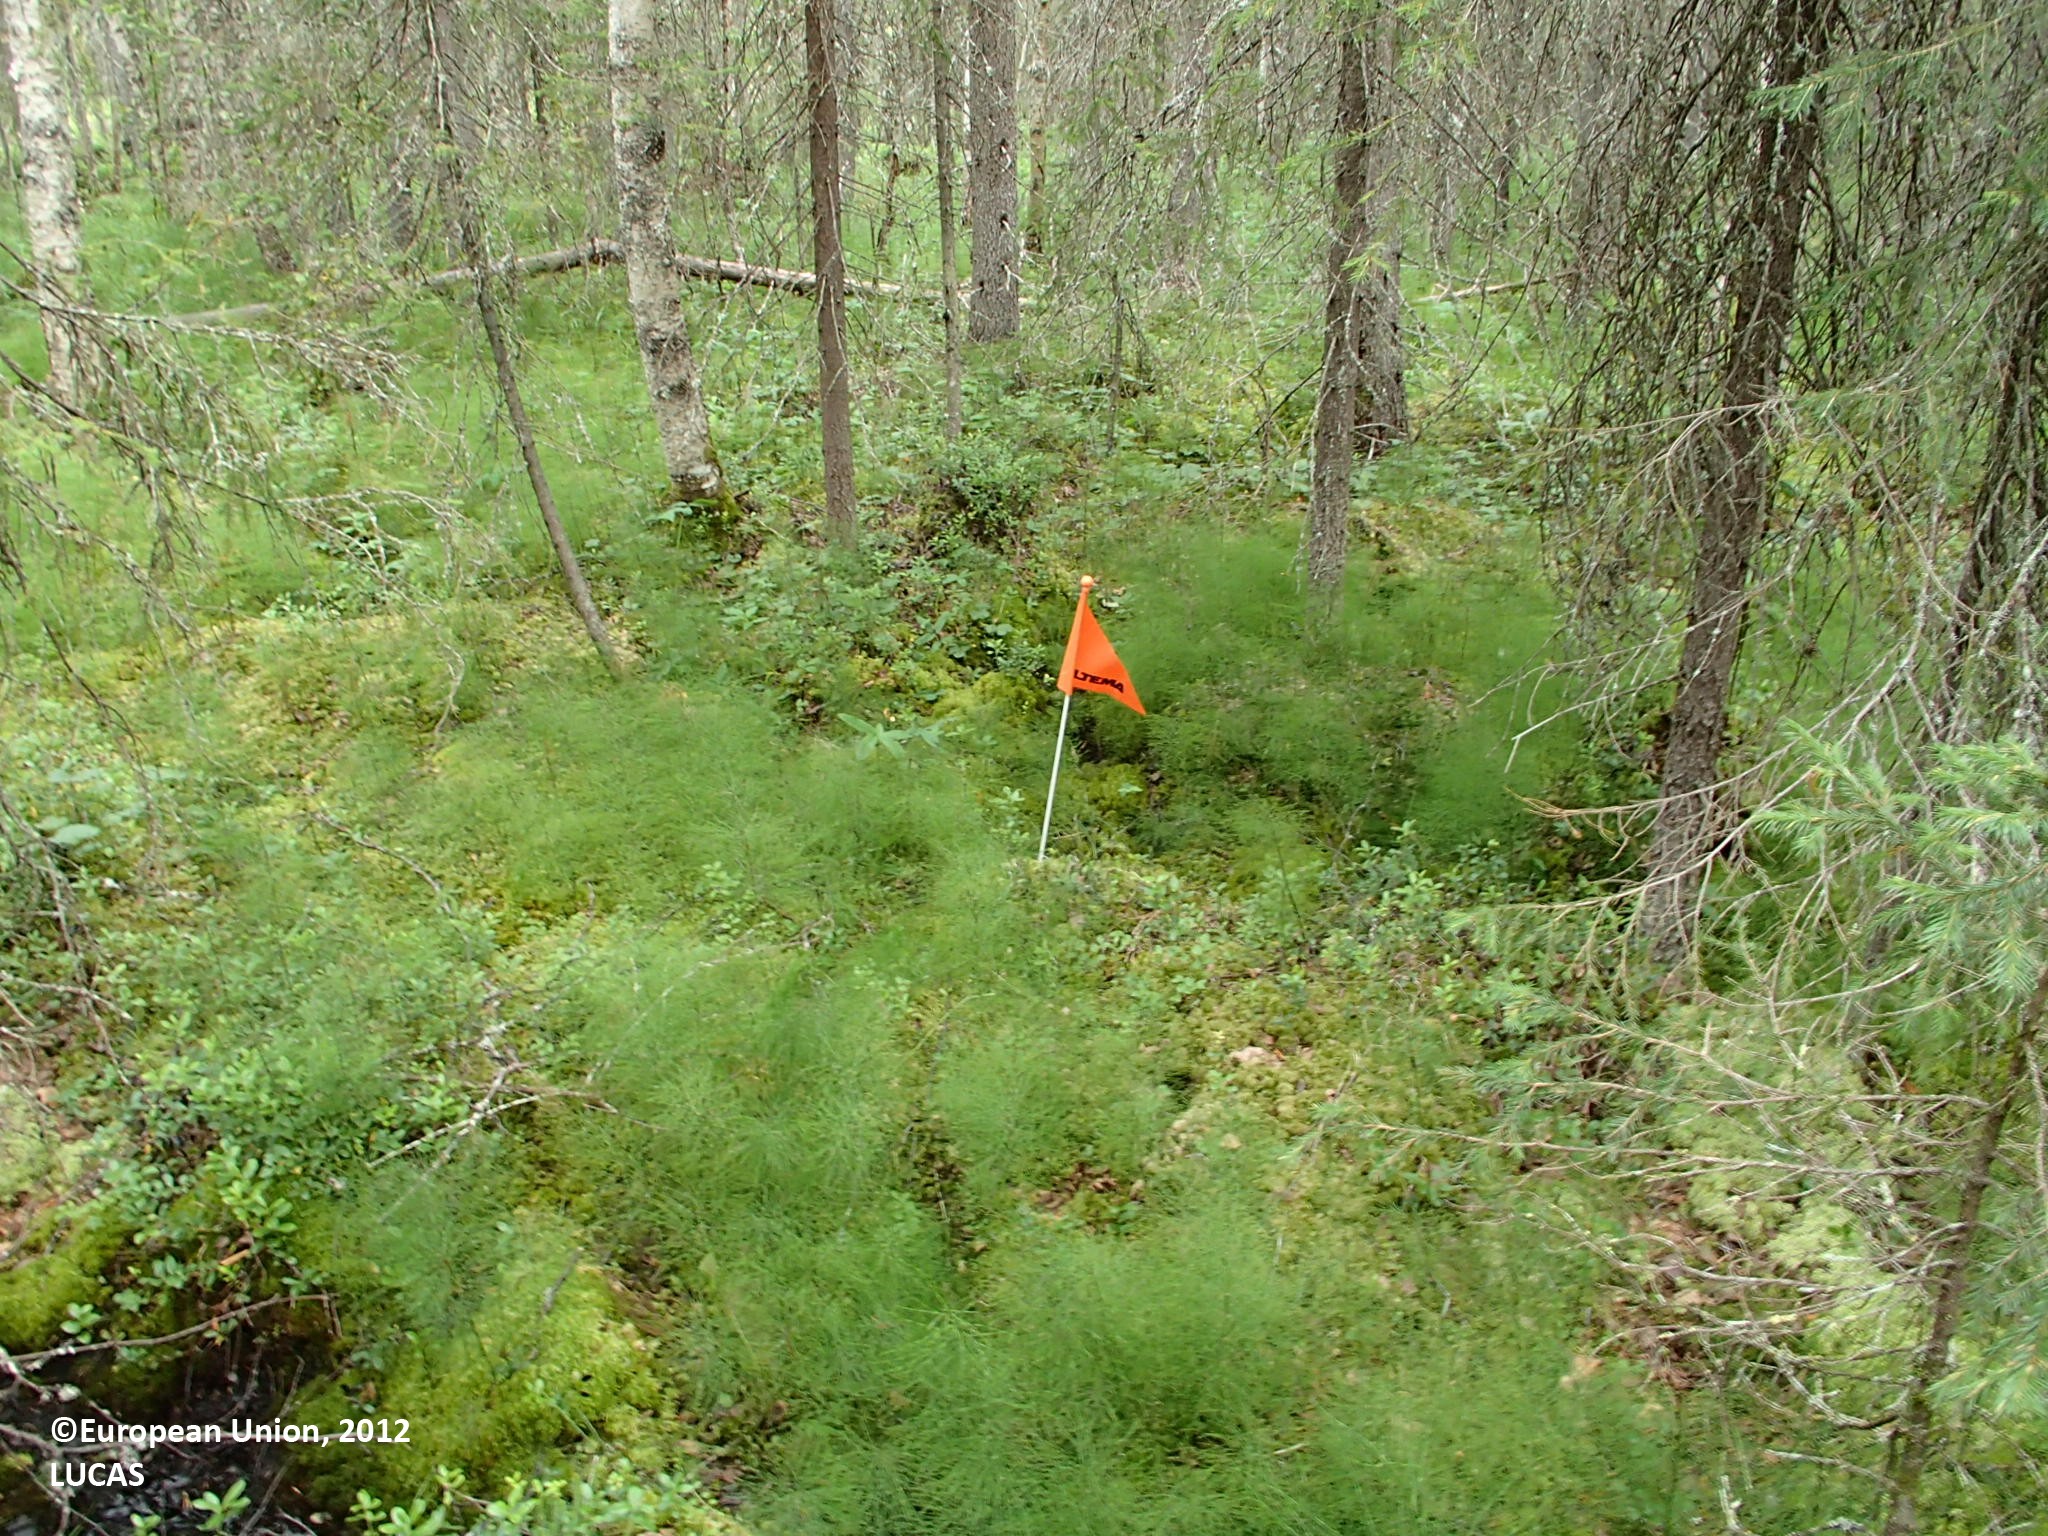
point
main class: Woodland
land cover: Other coniferous woodland
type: boreal forest
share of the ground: > 75 %
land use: Forestry
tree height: > 5 m
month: July
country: FI
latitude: 66.4151
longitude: 25.4056
